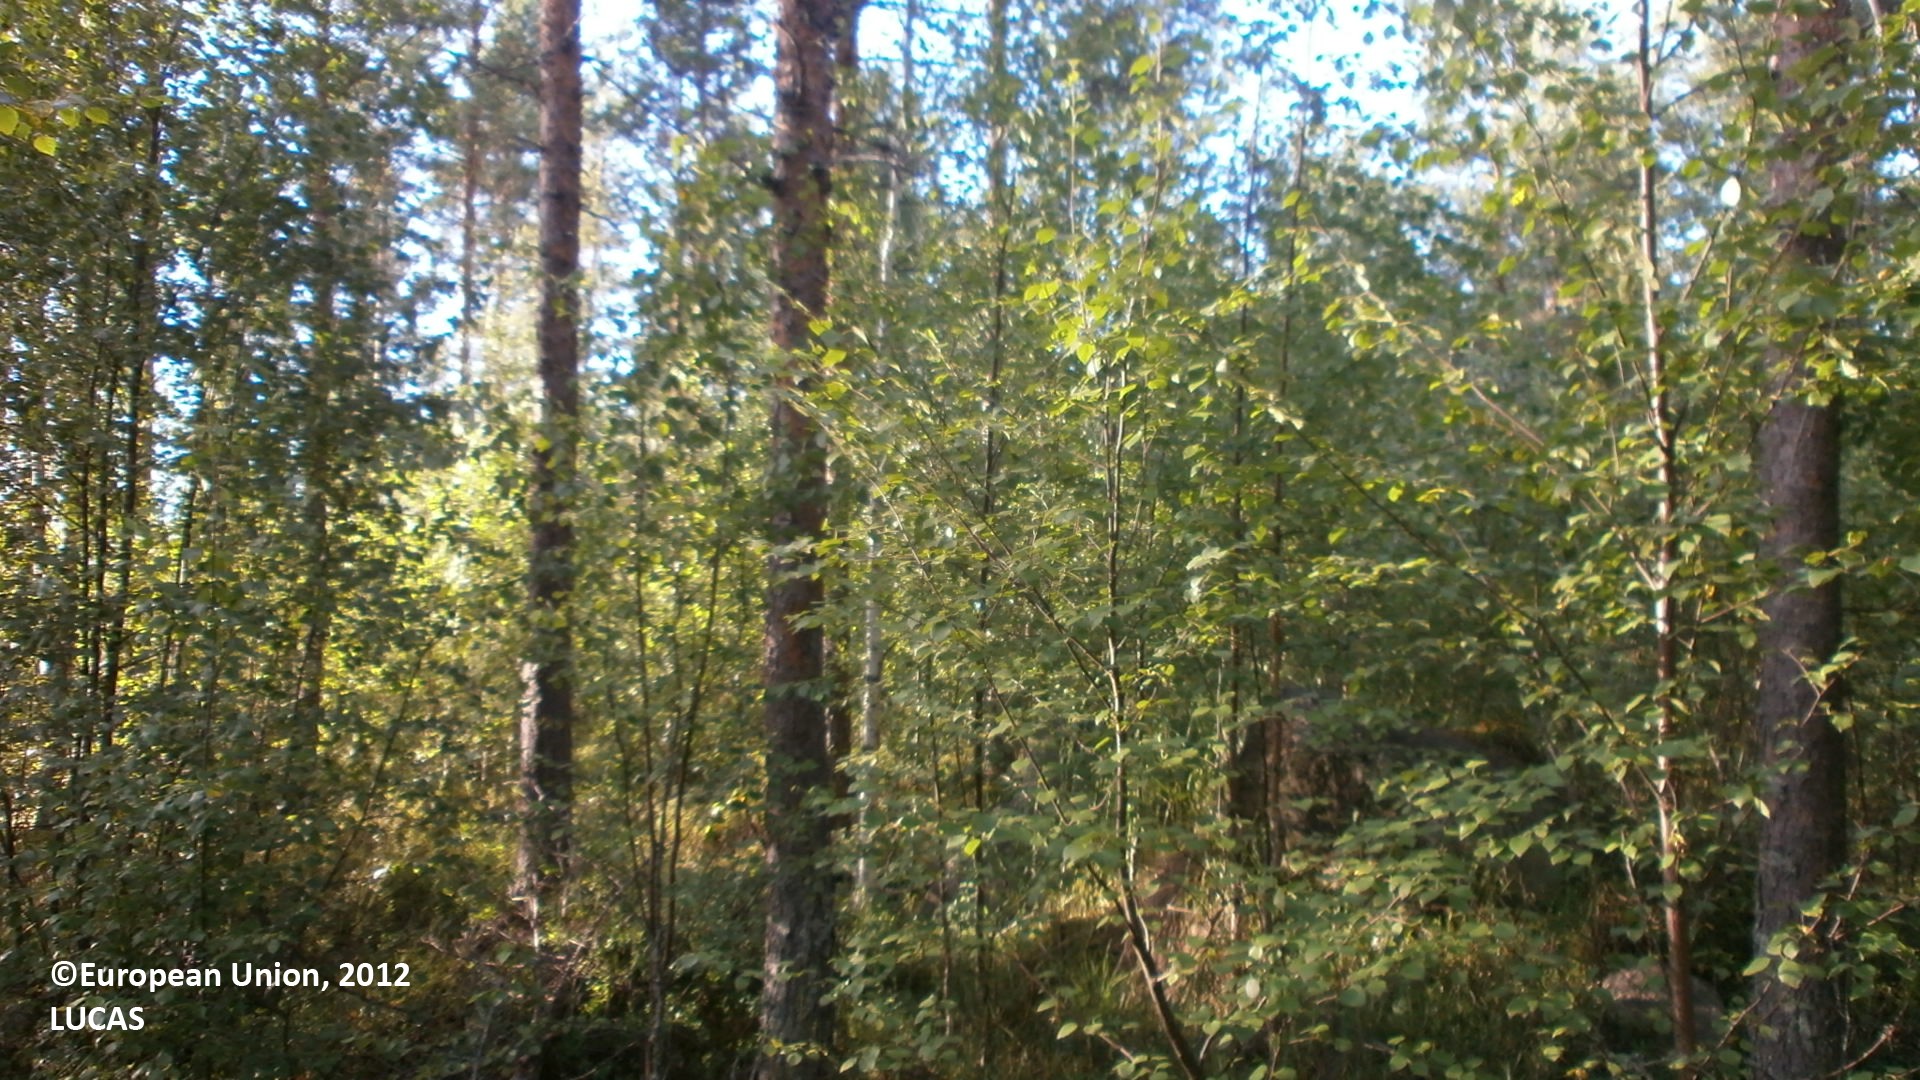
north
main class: Woodland
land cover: Pine dominated mixed woodland
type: boreal forest
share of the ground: > 75 %
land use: Forestry
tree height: > 5 m
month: July
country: FI
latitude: 64.0758
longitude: 24.3189
